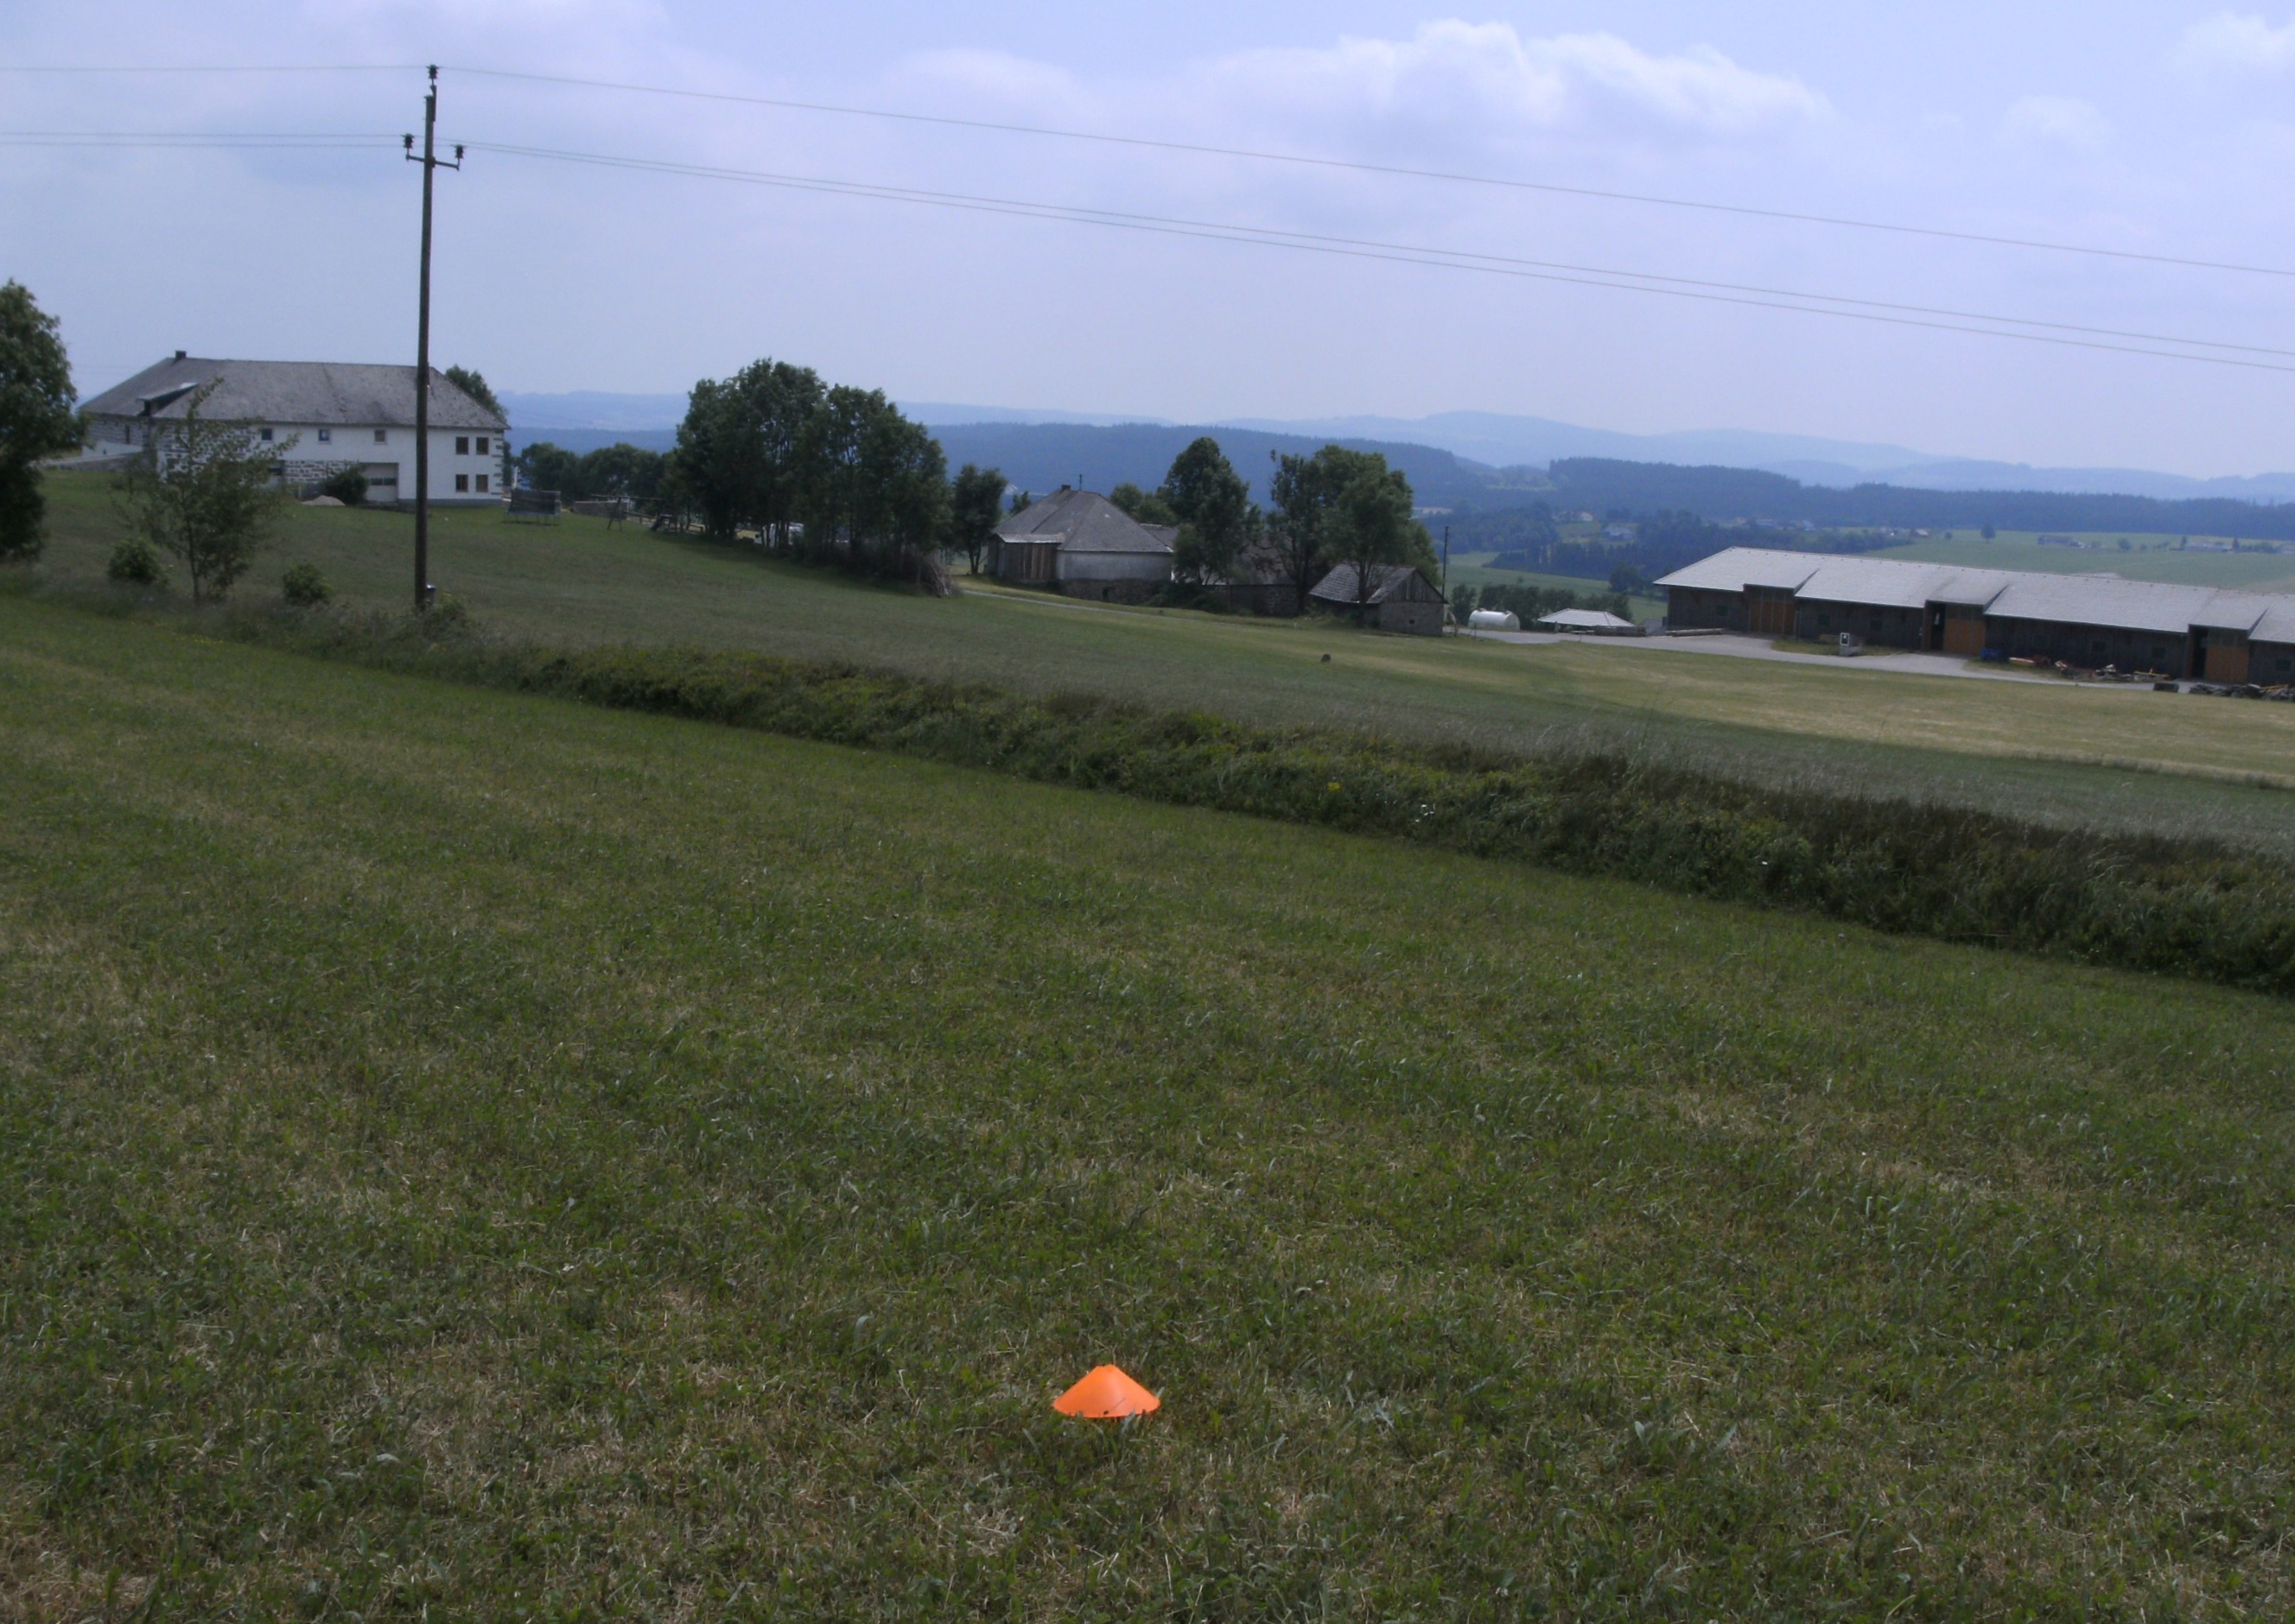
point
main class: Grassland
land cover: Grassland without tree/shrub cover
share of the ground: > 75 %
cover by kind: herbaceous plants 100 %
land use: Agriculture (excluding fallow land and kitchen gardens)
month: June
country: AT
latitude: 48.5564
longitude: 14.2411
